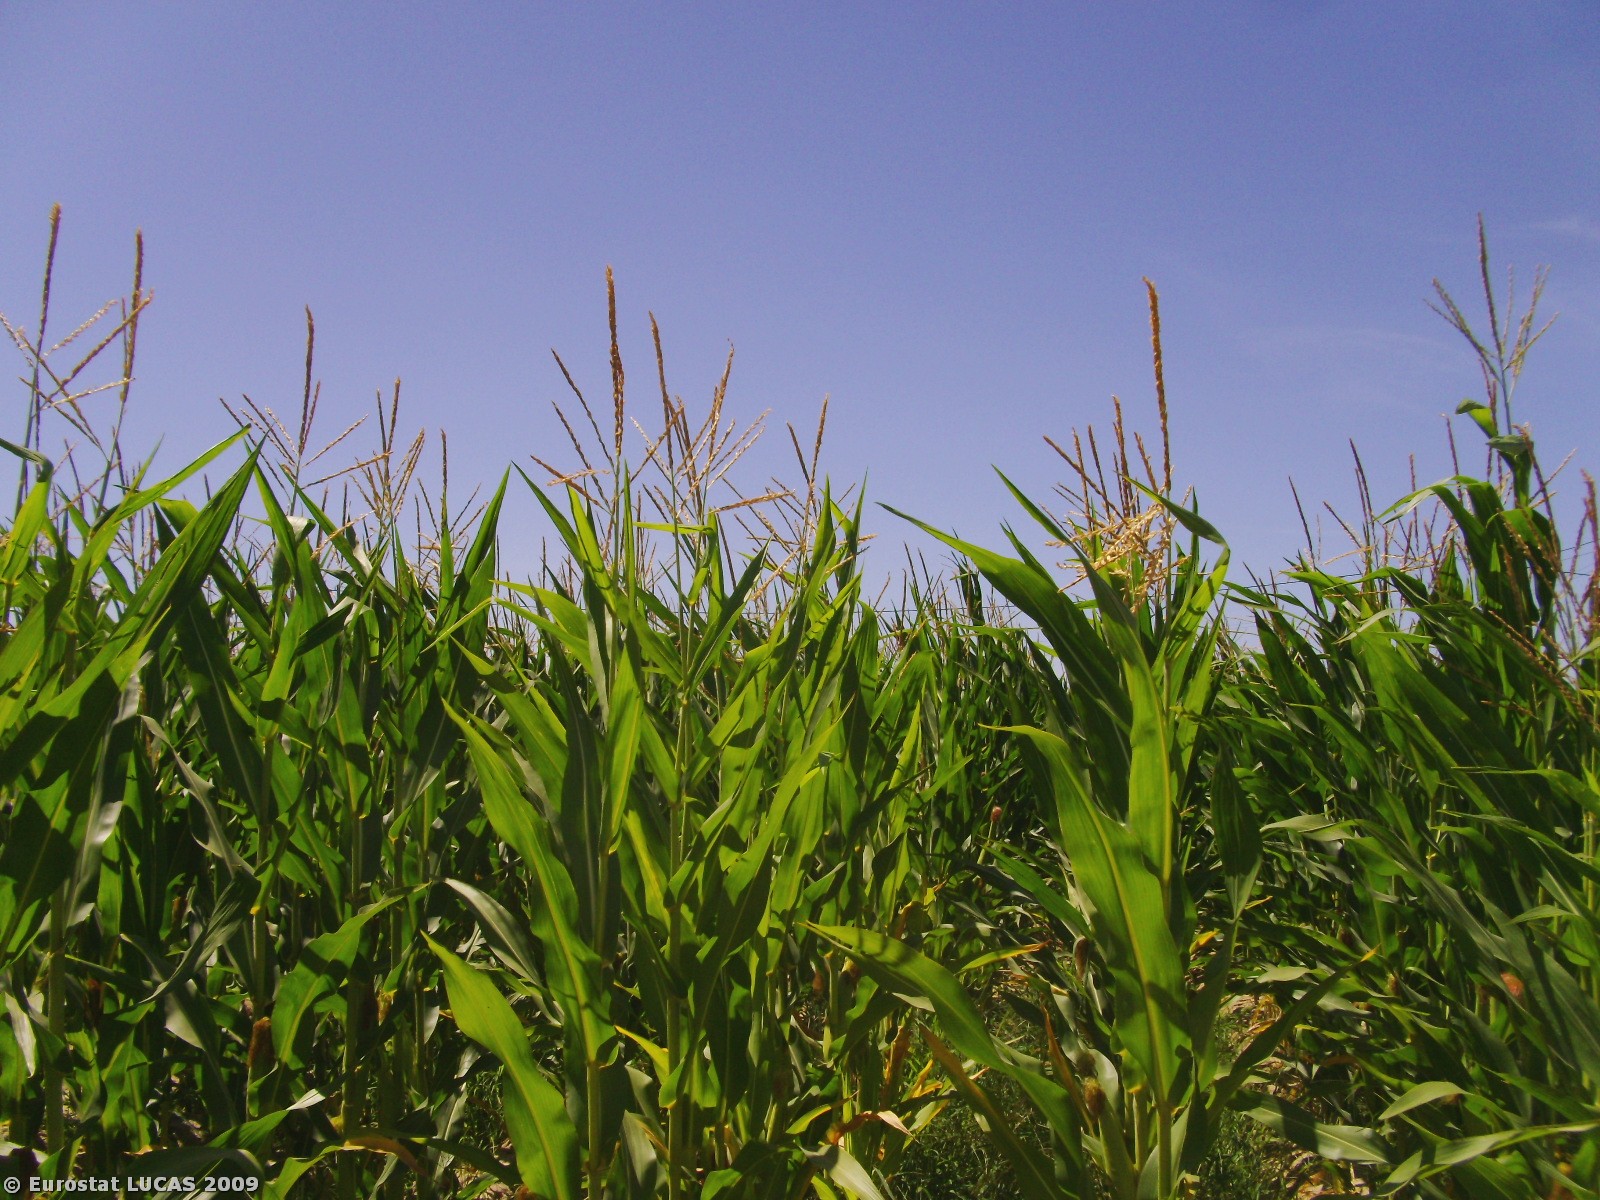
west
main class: Cropland
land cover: Maize
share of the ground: > 75 %
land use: Agriculture (excluding fallow land and kitchen gardens)
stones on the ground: 25 - 50 %
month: August
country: PT
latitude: 38.7052
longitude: -8.7263
